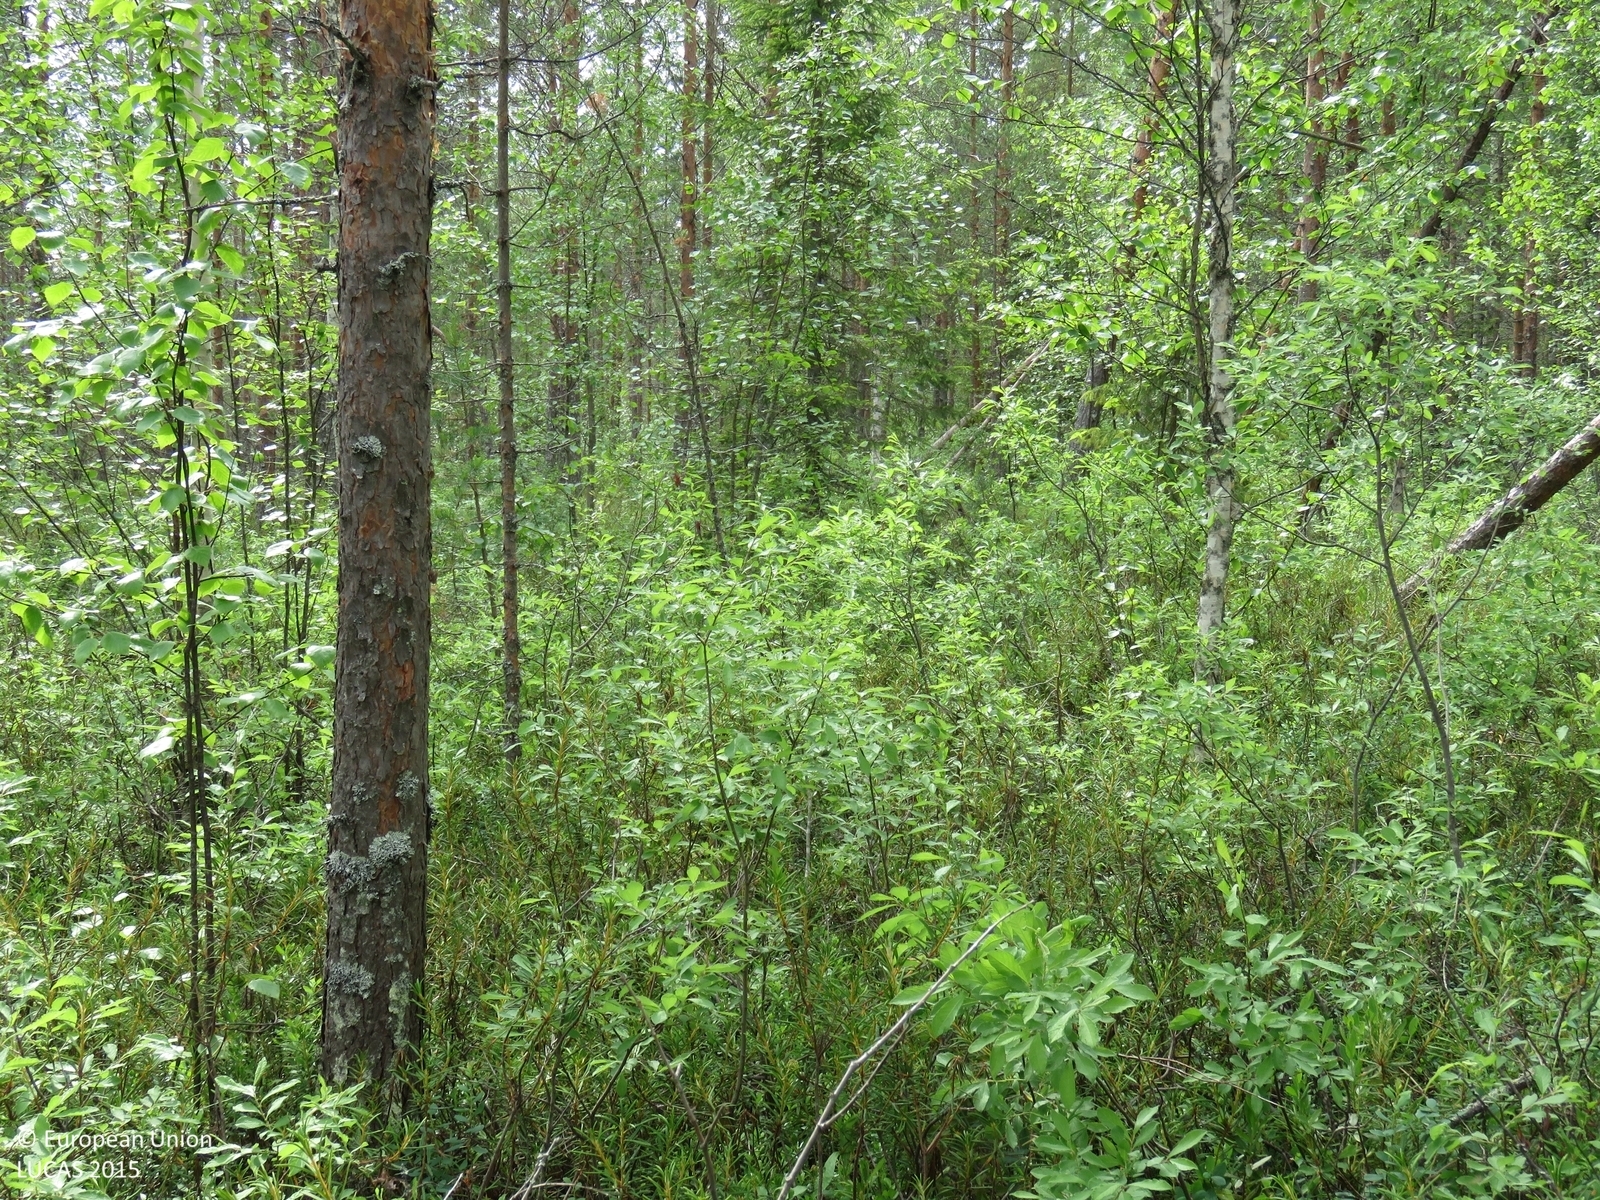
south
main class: Woodland
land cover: Pine dominated mixed woodland
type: boreal forest
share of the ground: > 75 %
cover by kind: coniferous forest trees 50 %, broadleaved forest trees 30 %, shrubs 20 %
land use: Forestry
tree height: > 5 m
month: July
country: FI
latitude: 64.2206
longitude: 26.5865
